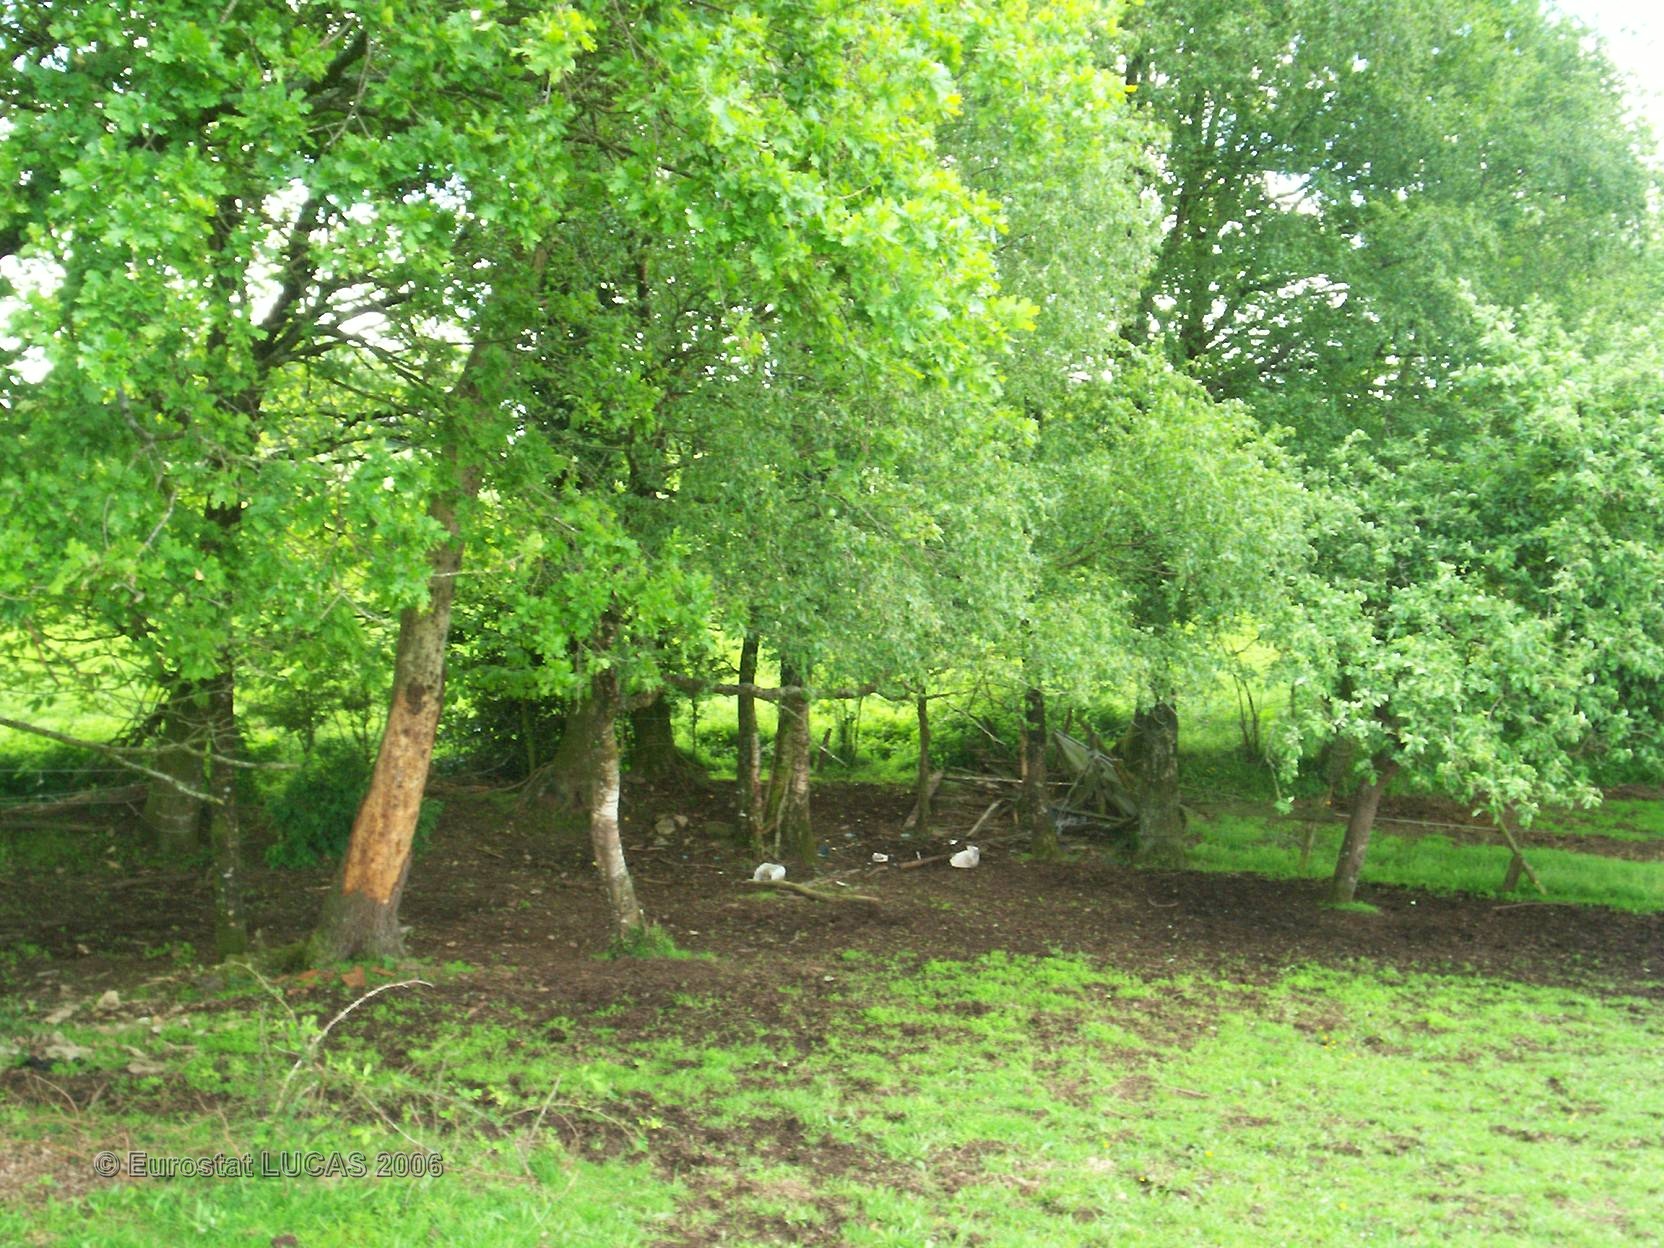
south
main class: Grassland
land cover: Grassland without tree/shrub cover
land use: Agriculture (excluding fallow land and kitchen gardens)
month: May
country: FR
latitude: 47.7292
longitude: -2.7961
